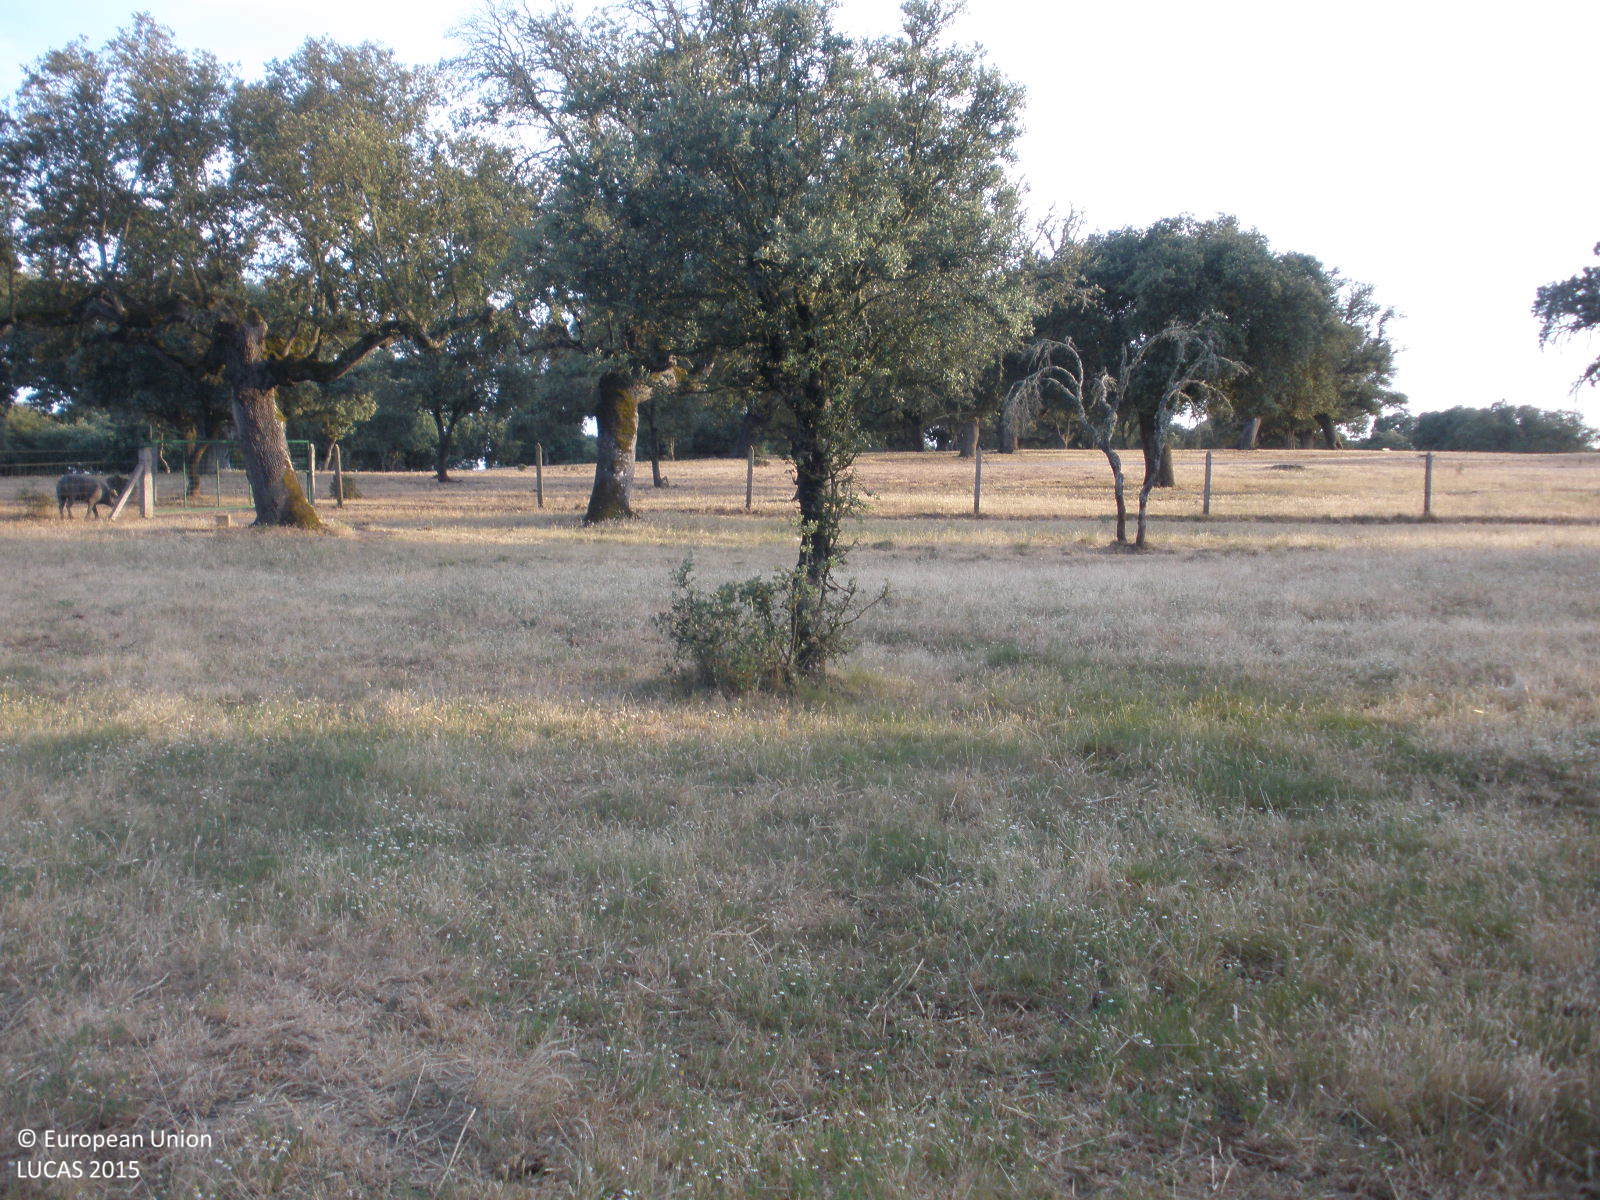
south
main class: Woodland
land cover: Broadleaved woodland
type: broadleaved evergreen forest
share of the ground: 50 - 75 %
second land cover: Grassland without tree/shrub cover
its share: > 75 %
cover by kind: broadleaved forest trees 50 %, herbaceous plants 50 %
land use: Forestry
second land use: Agriculture (excluding fallow land and kitchen gardens)
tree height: > 5 m
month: June
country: ES
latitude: 40.6253
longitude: -6.7278
